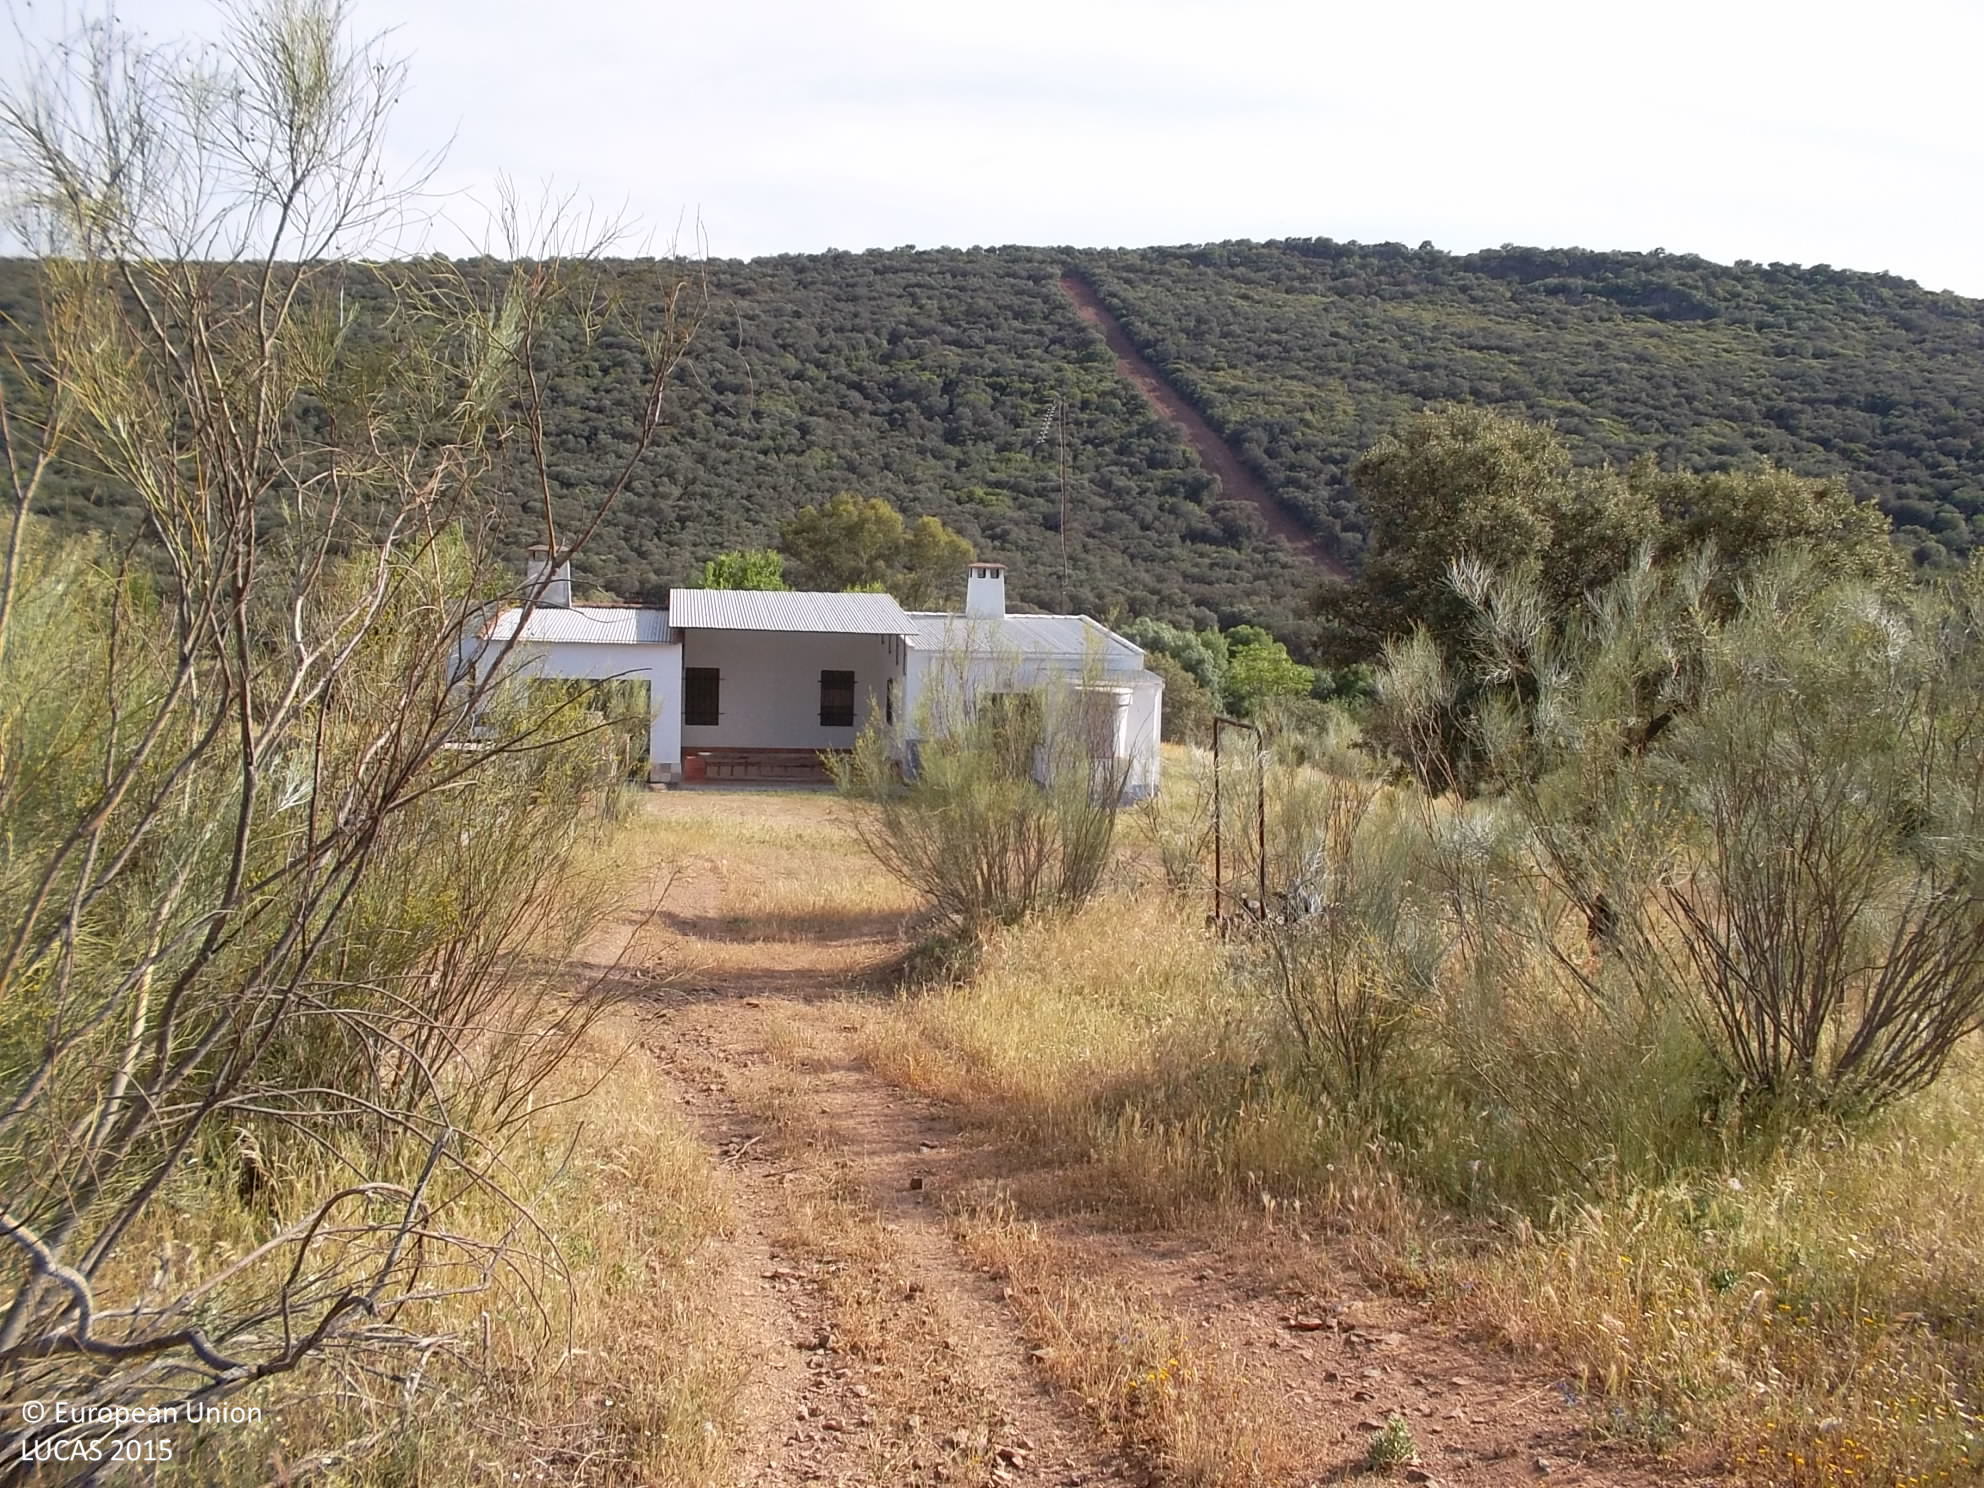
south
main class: Shrubland
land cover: Shrubland with sparse tree cover
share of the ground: 10 - 25 %
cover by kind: herbaceous plants 85 %, shrubs 10 %, broadleaved forest trees 5 %
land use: Agriculture (excluding fallow land and kitchen gardens)
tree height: > 5 m
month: May
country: ES
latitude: 38.7605
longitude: -4.7468
